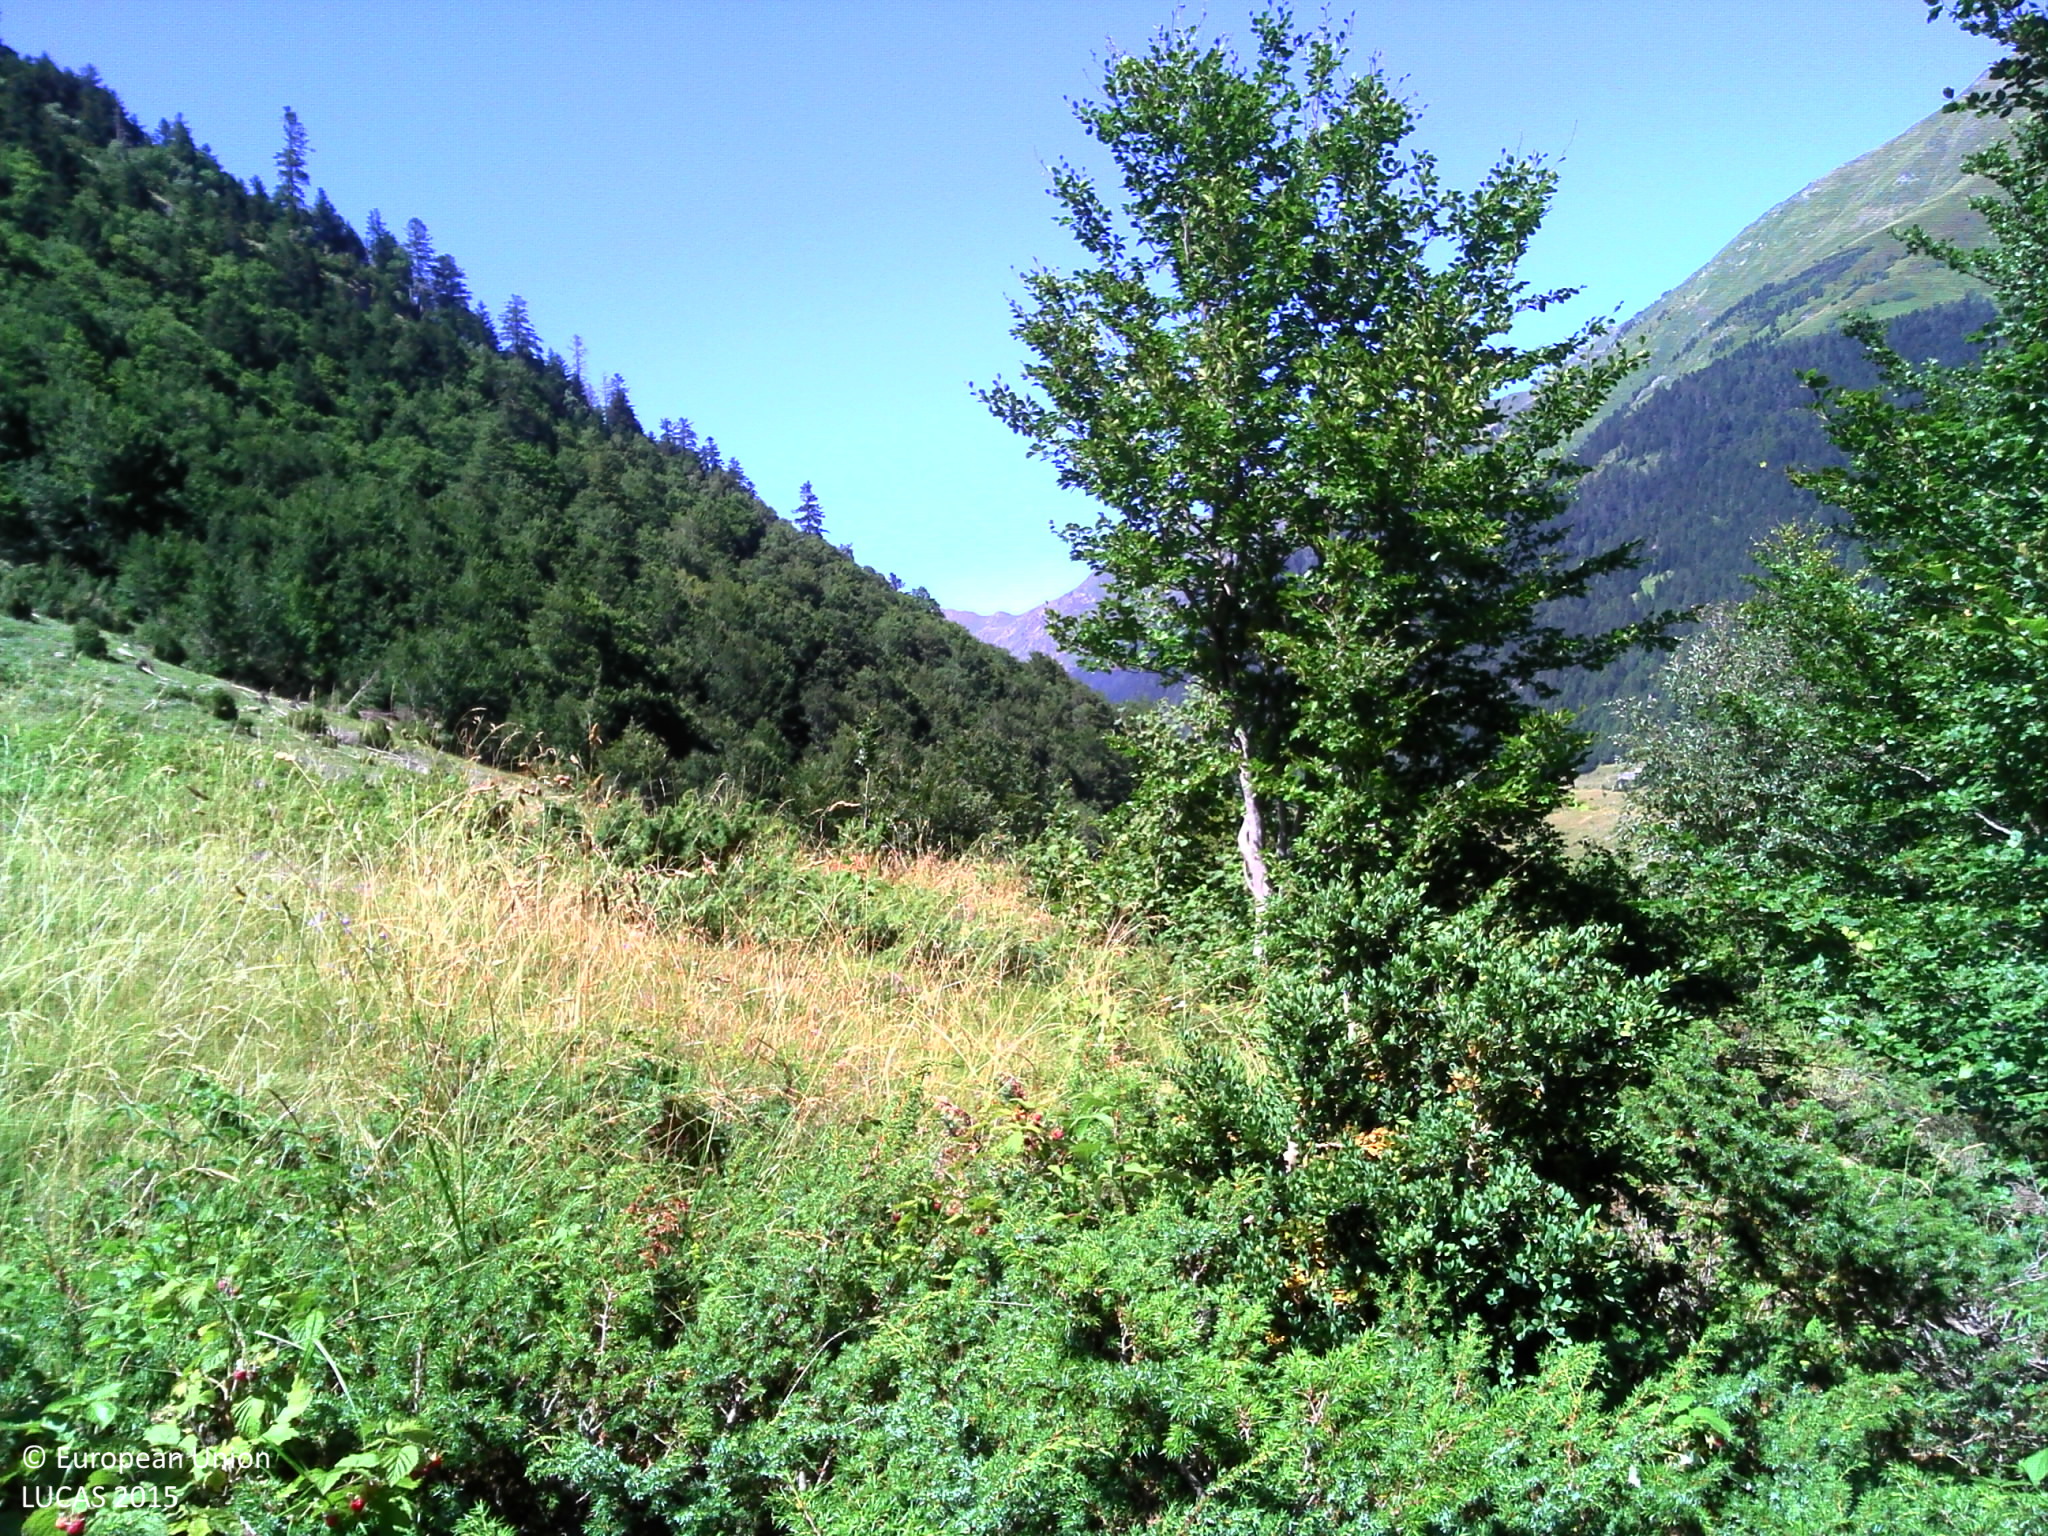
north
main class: Woodland
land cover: Broadleaved woodland
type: beech forest
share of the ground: 25 - 50 %
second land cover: Grassland without tree/shrub cover
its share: 50 - 75 %
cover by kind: herbaceous plants 40 %, broadleaved forest trees 35 %, shrubs 15 %, lichens and mosses 5 %, consolidated bare surface 5 %
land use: Forestry
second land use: Agriculture (excluding fallow land and kitchen gardens)
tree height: > 5 m
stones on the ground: 10 - 25 %
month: July
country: FR
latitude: 42.8278
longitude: -0.3890
